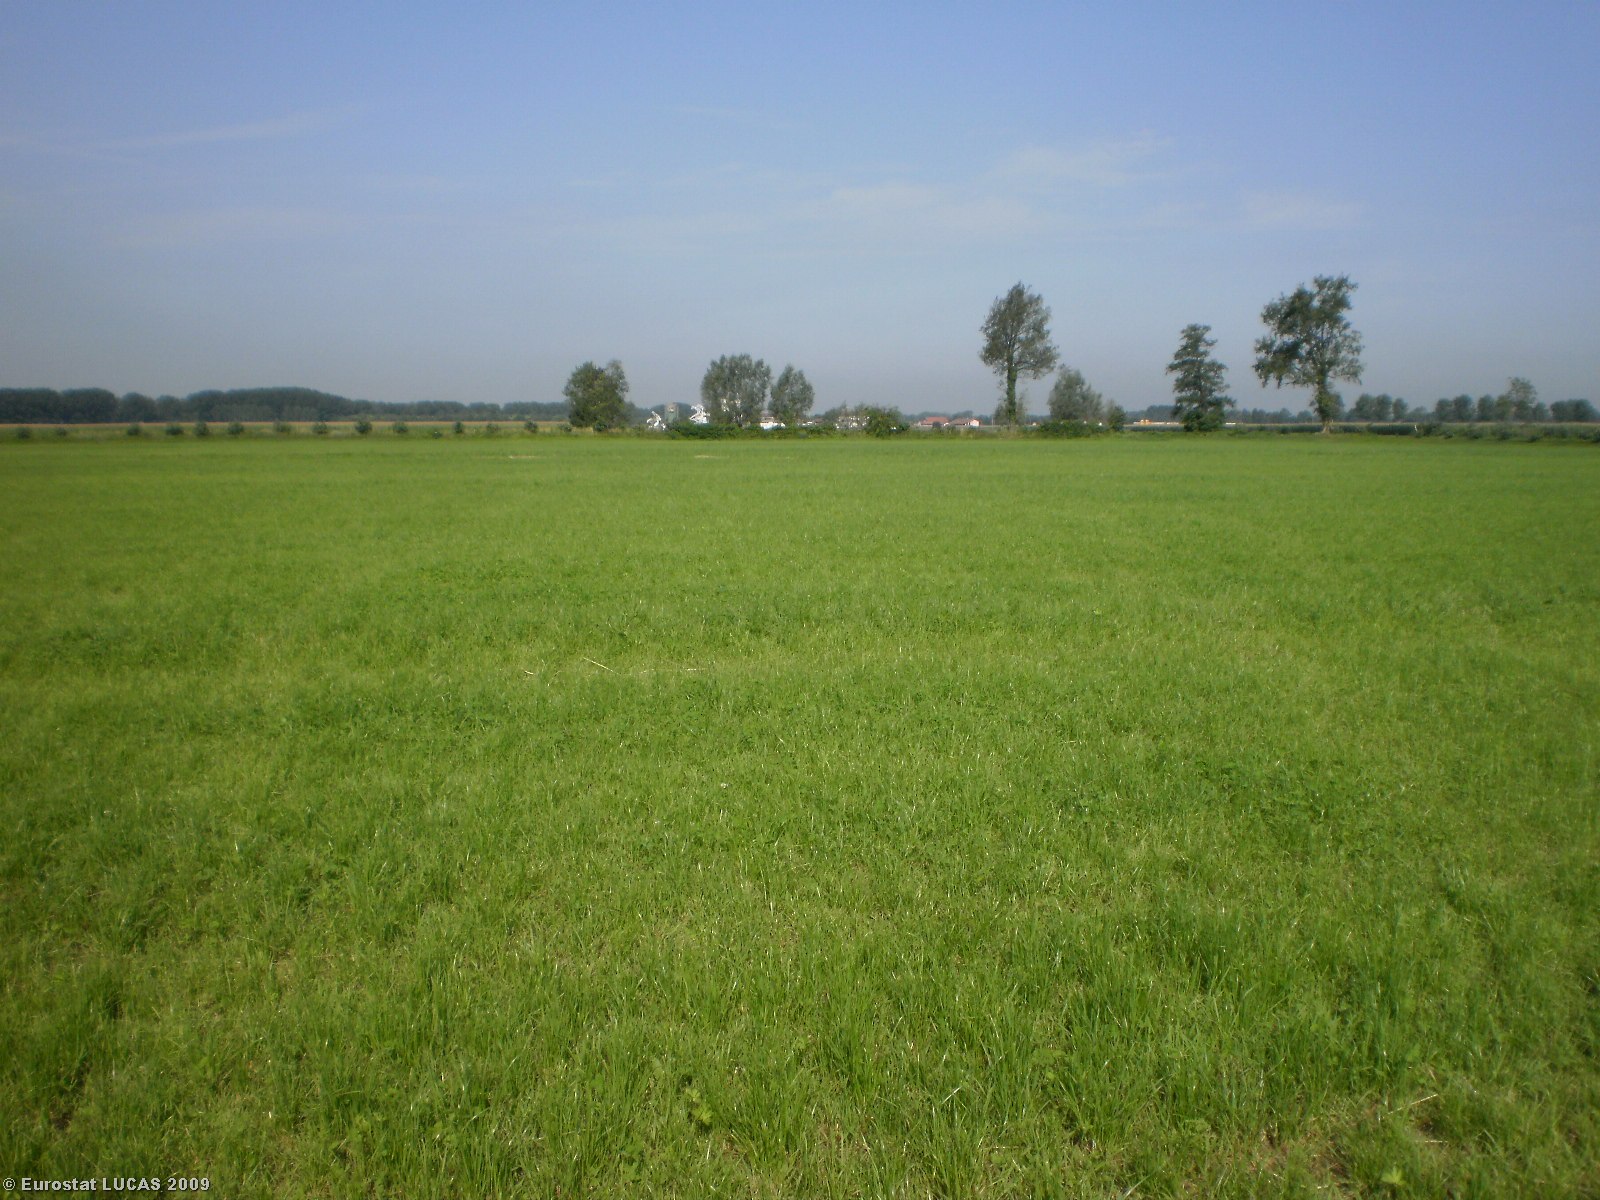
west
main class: Grassland
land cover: Grassland without tree/shrub cover
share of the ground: > 75 %
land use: Agriculture (excluding fallow land and kitchen gardens)
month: July
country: IT
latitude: 45.4131
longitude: 9.5025
